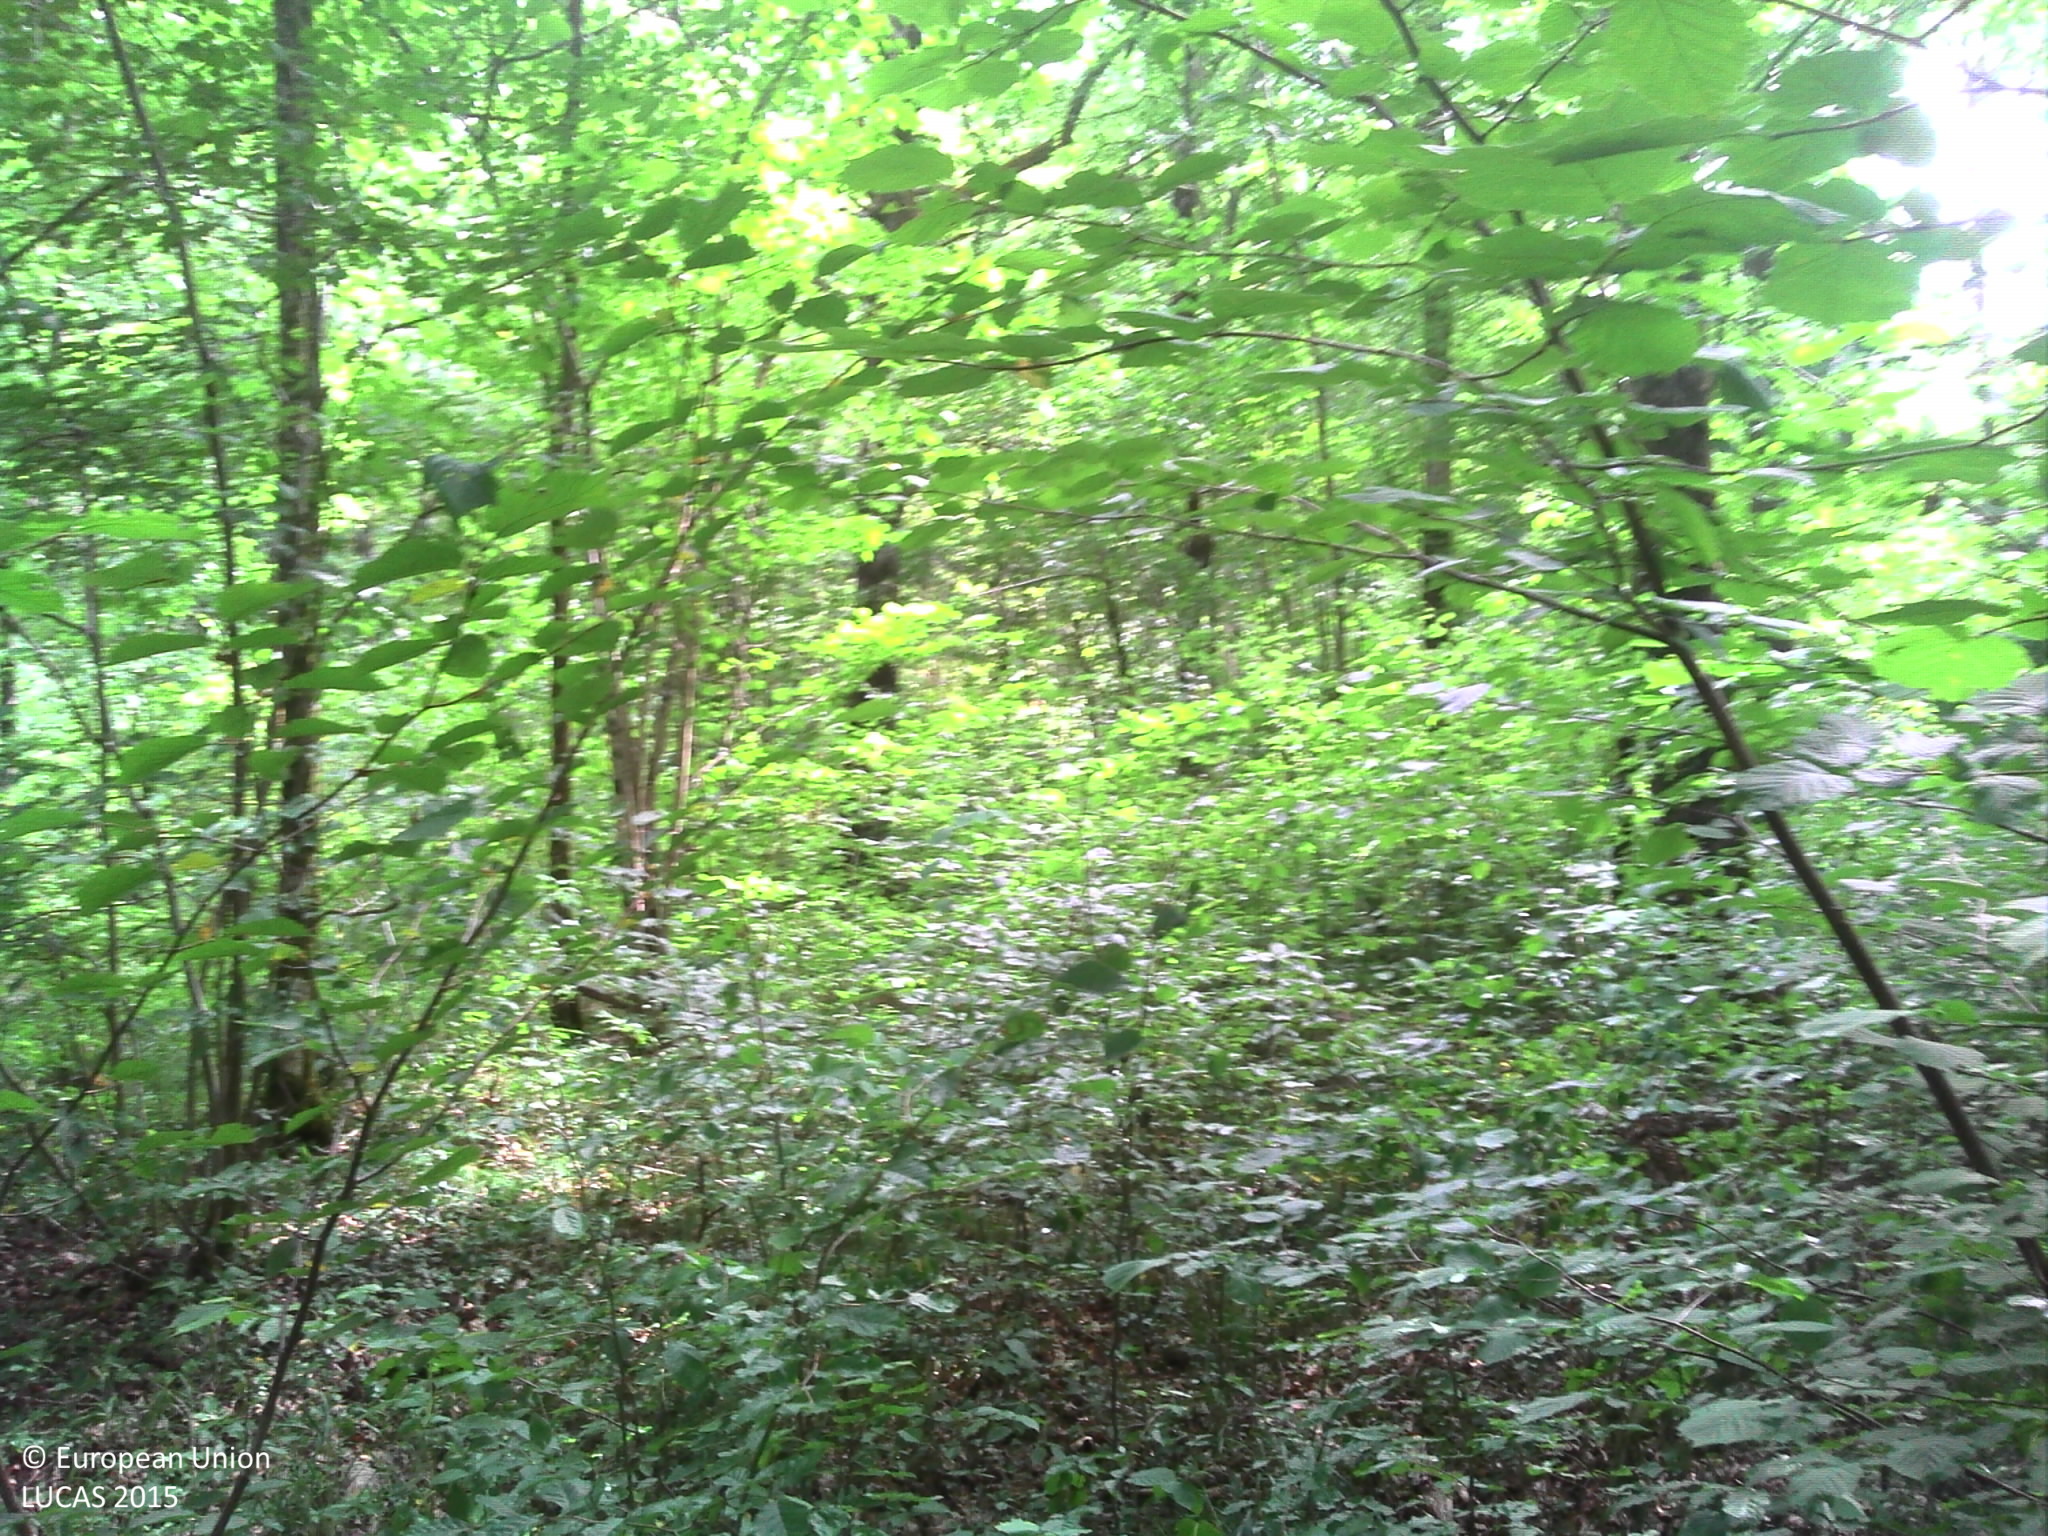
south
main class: Woodland
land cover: Broadleaved woodland
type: acidophilous oak and oak-birch forest
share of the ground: > 75 %
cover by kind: broadleaved forest trees 80 %, herbaceous plants 10 %, lichens and mosses 10 %
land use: Forestry
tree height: > 5 m
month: July
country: FR
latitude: 47.9110
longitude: 4.9819
